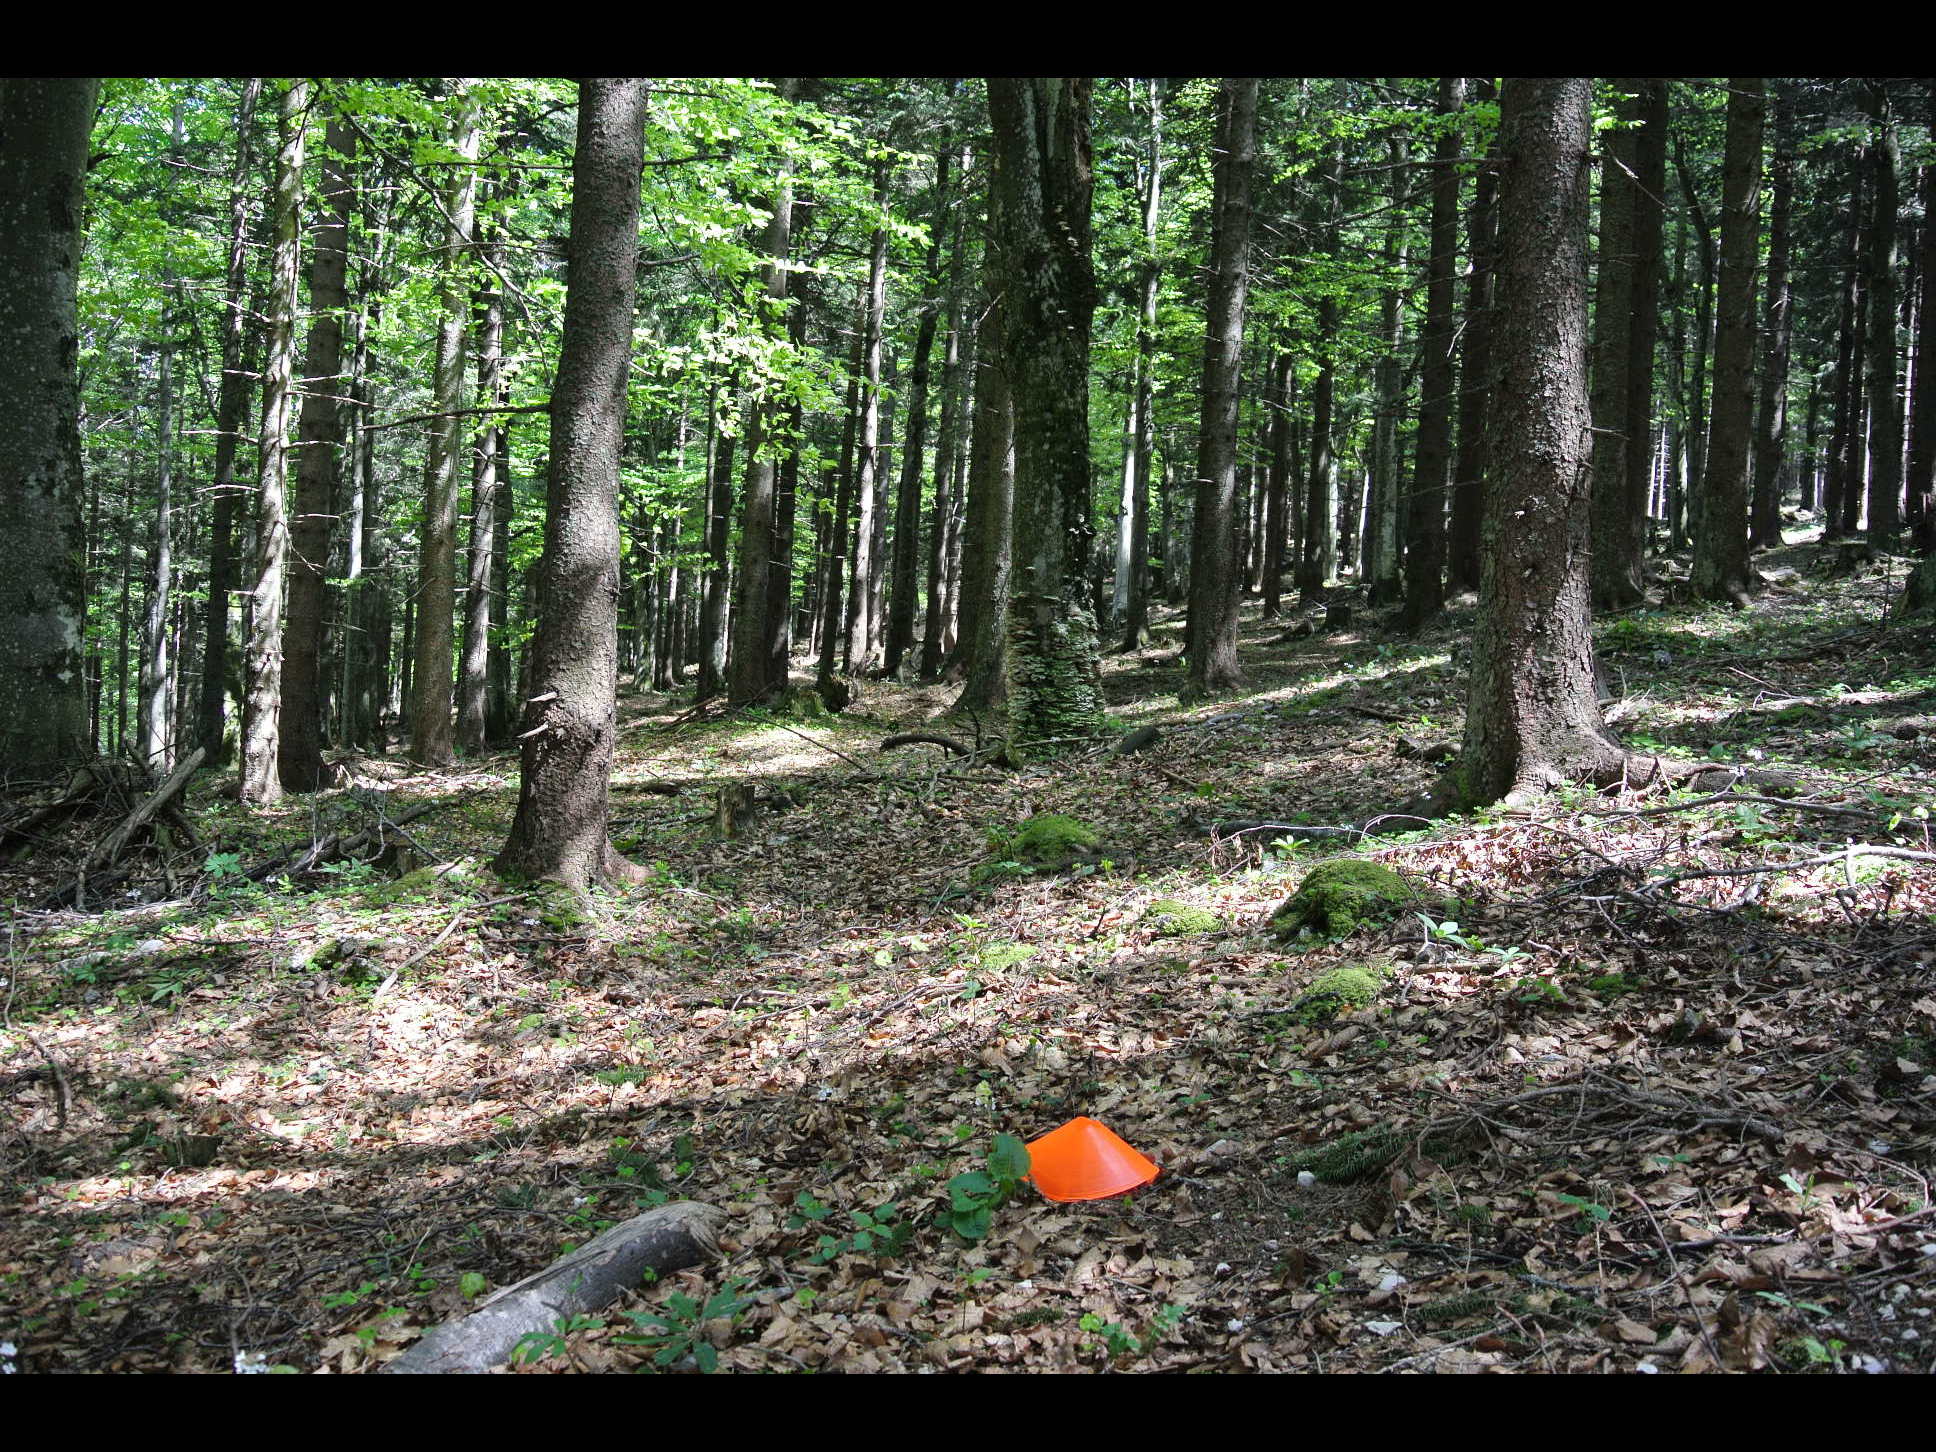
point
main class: Woodland
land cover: Spruce dominated mixed woodland
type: alpine coniferous forest
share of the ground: > 75 %
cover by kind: coniferous forest trees 70 %, broadleaved forest trees 30 %
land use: Forestry
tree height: > 5 m
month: May
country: AT
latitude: 47.7266
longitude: 15.8285
